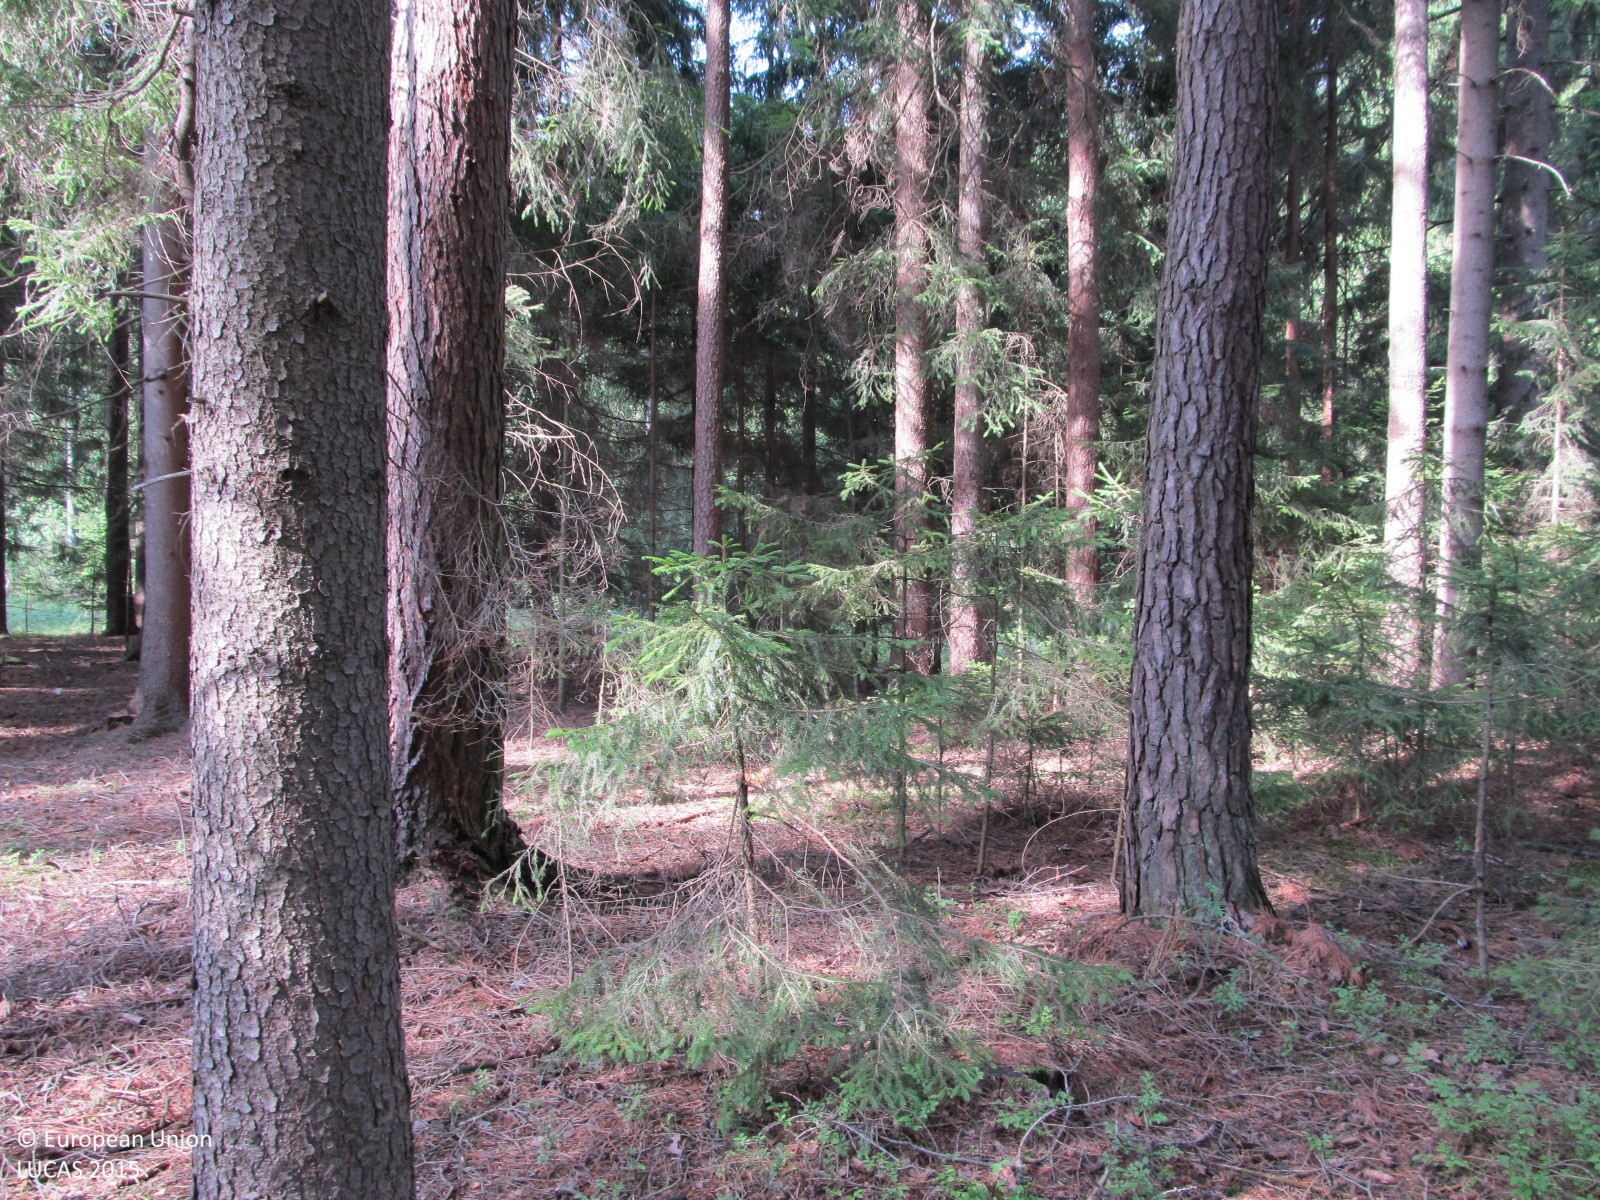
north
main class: Woodland
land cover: Other coniferous woodland
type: hemiboreal forest and nemoral coniferous forest and mixed broadleaved-coniferous forest
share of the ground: > 75 %
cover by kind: coniferous forest trees 80 %, unconsolidated bare surface 15 %, herbaceous plants 5 %
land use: Forestry
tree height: > 5 m
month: August
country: AT
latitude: 48.7198
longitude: 15.4536
